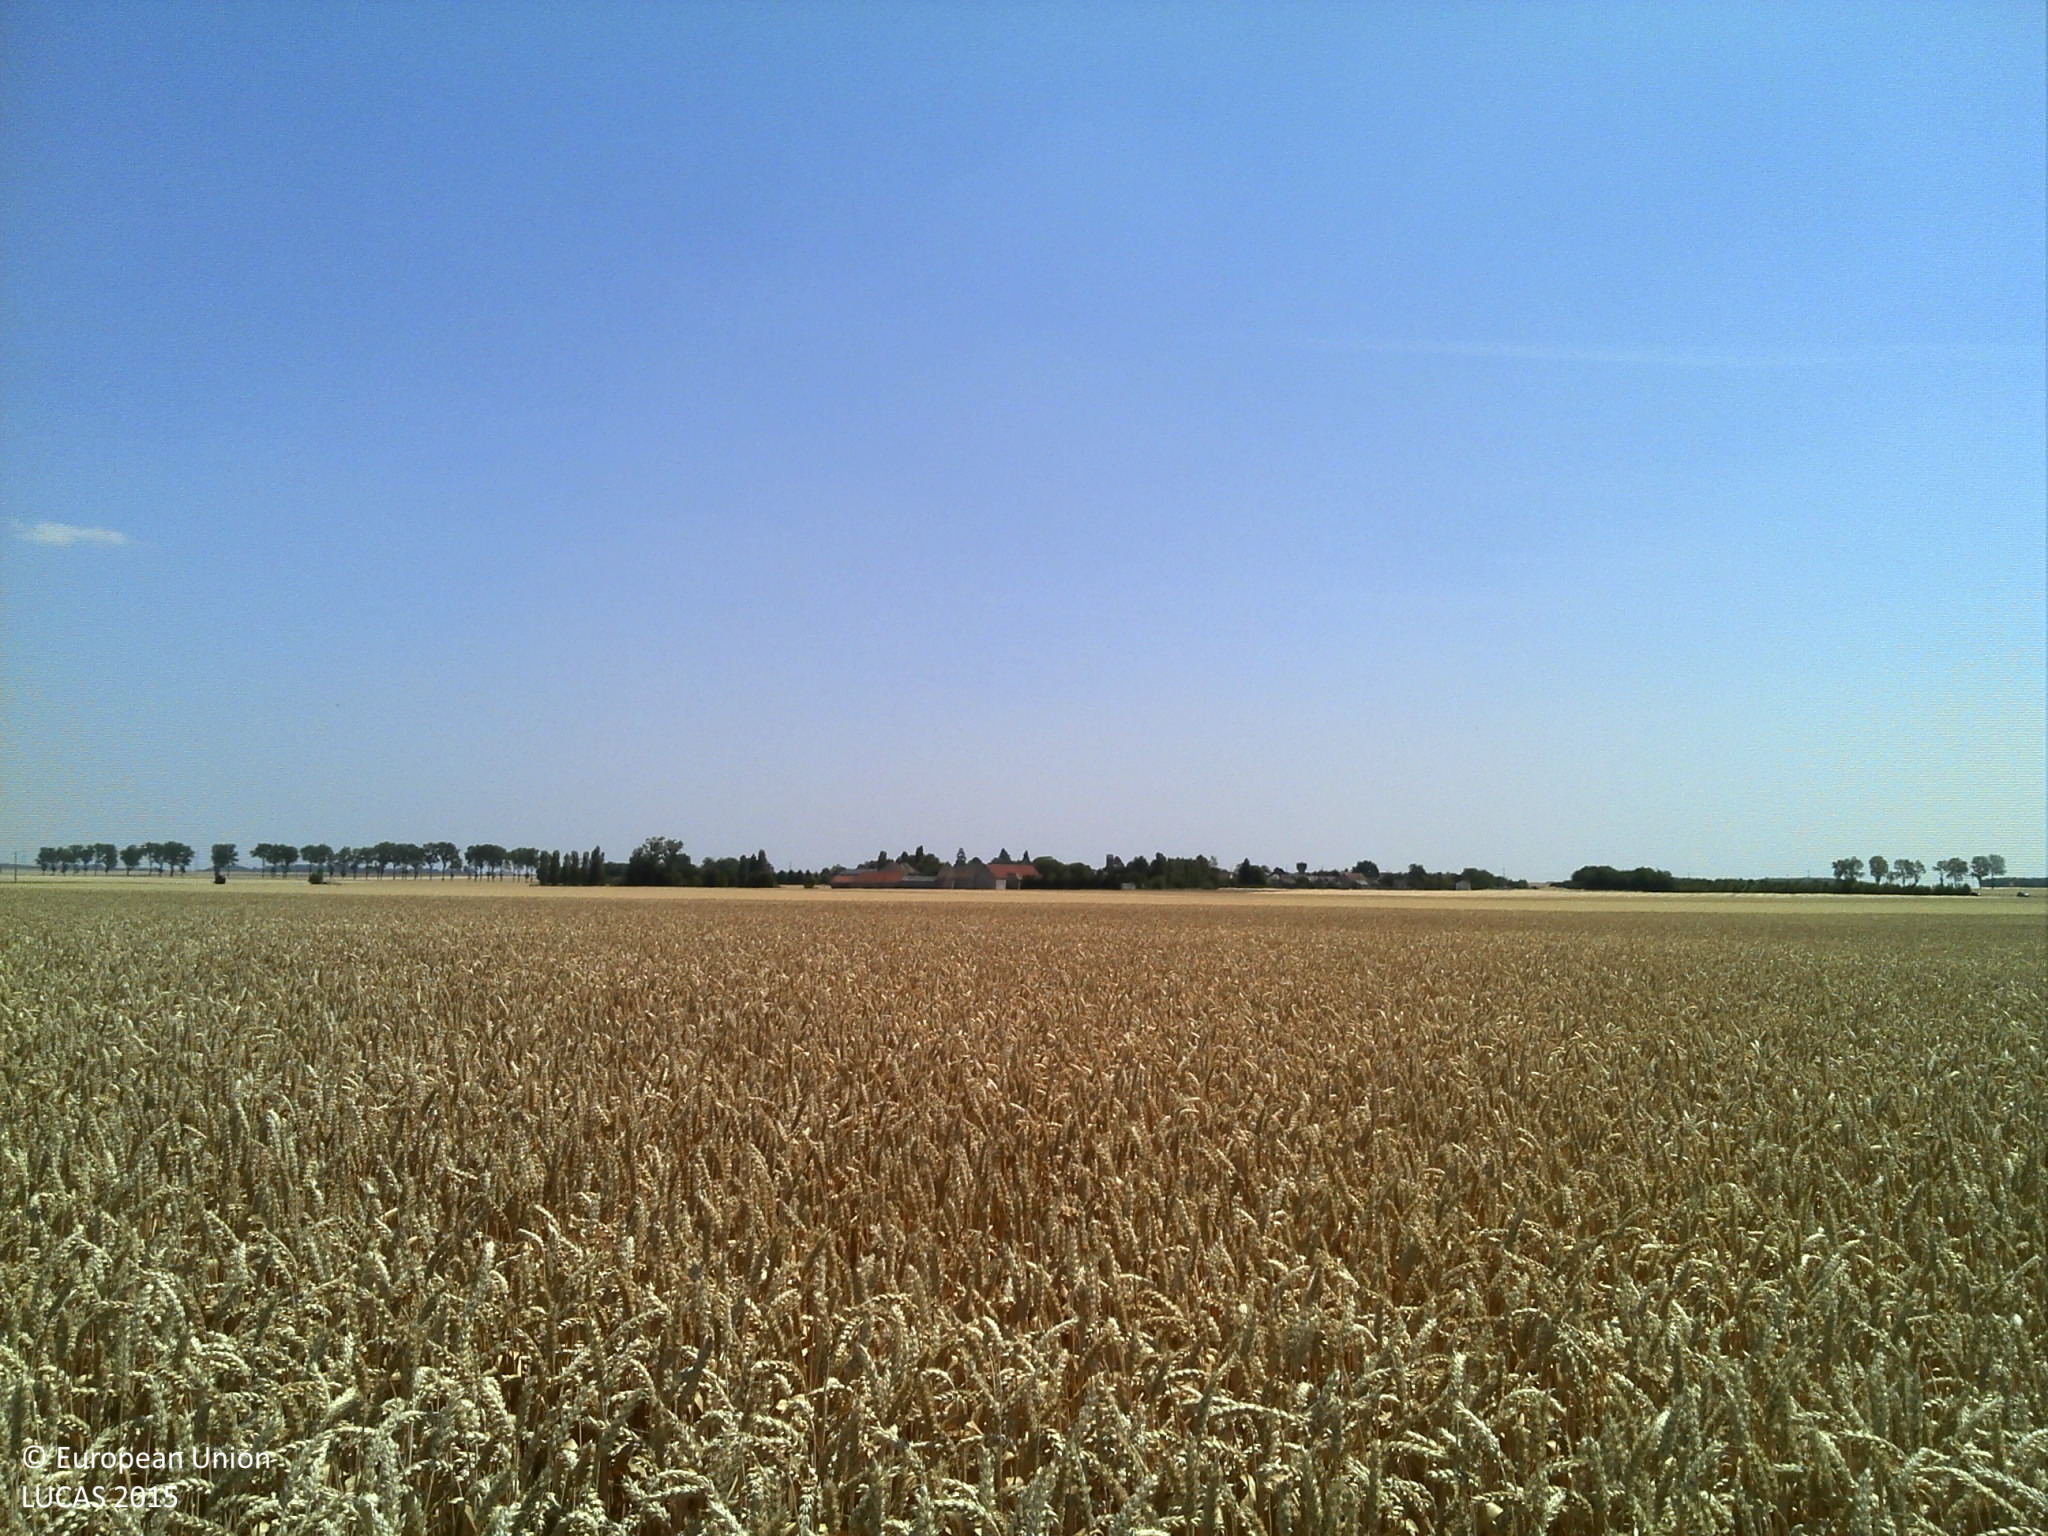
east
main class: Cropland
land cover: Common wheat
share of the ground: > 75 %
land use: Agriculture (excluding fallow land and kitchen gardens)
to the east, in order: Common wheat; Durum wheat
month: July
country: FR
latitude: 48.4526
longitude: 1.9412
